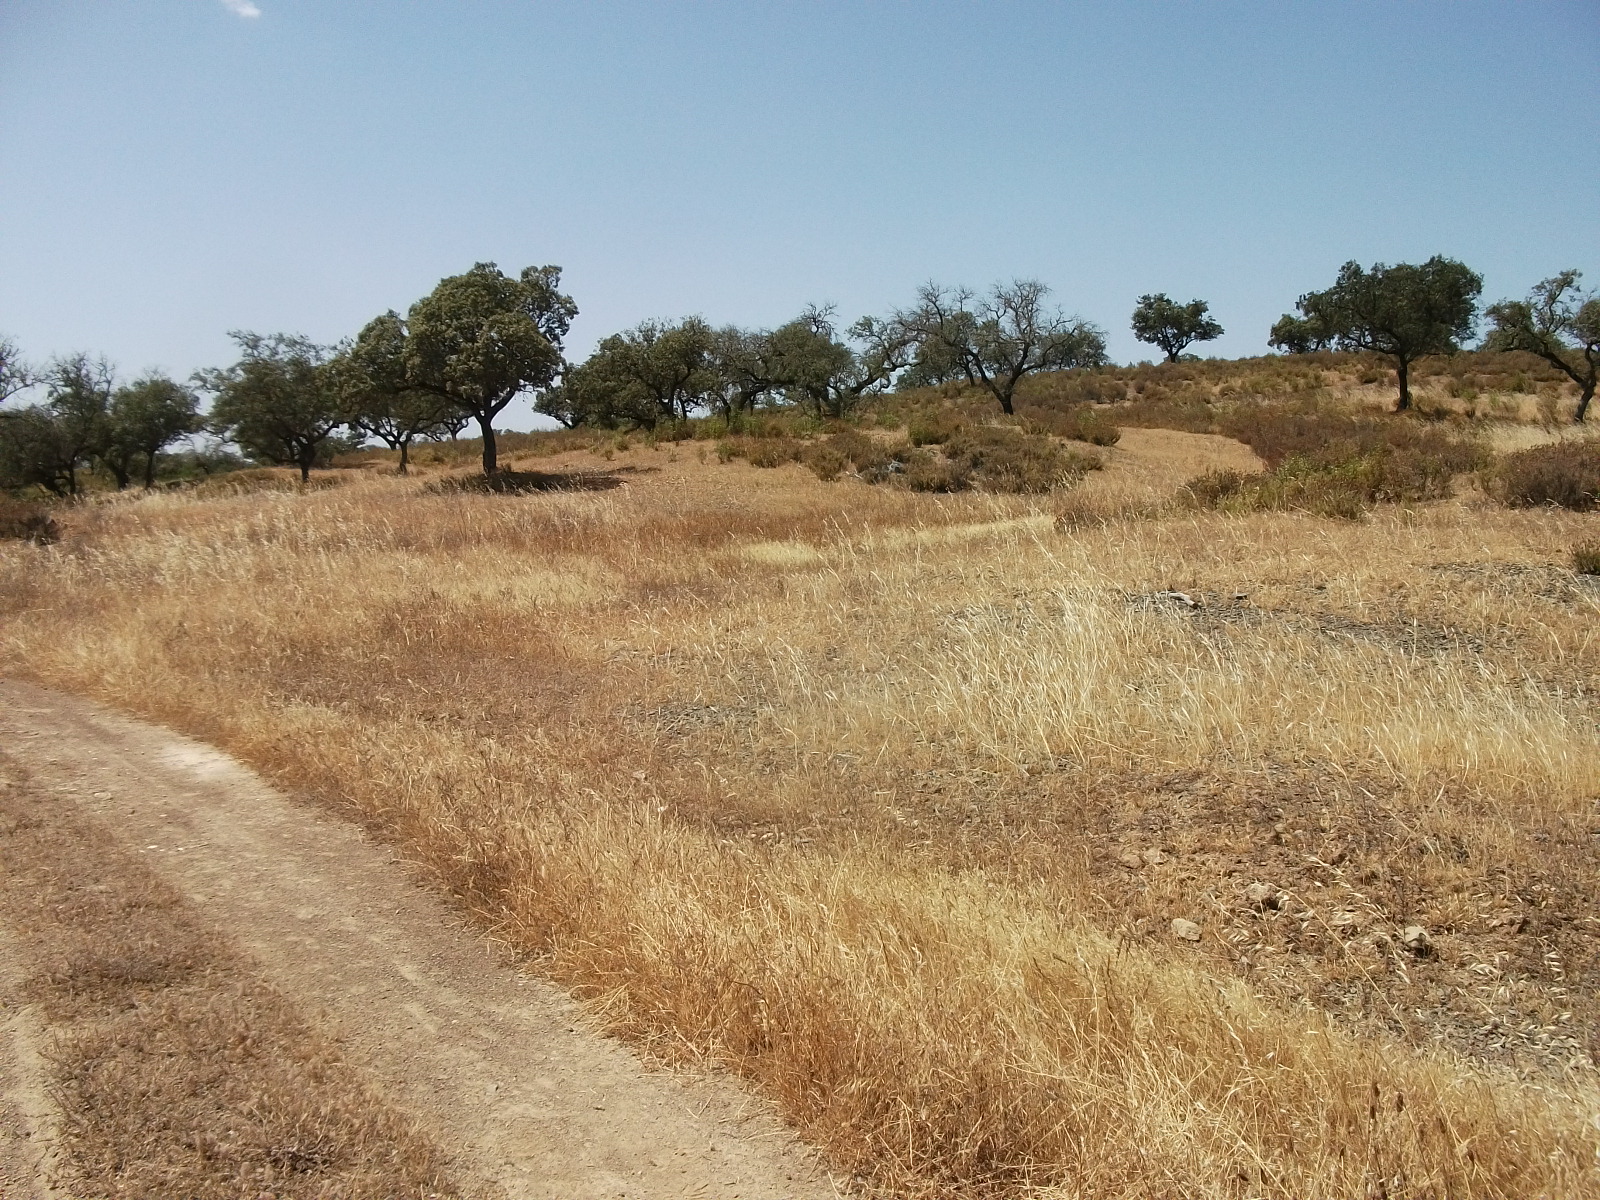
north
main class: Grassland
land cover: Grassland without tree/shrub cover
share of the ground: > 75 %
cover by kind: herbaceous plants 95 %, shrubs 5 %
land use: Agriculture (excluding fallow land and kitchen gardens)
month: June
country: ES
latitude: 37.5237
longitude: -6.9599
